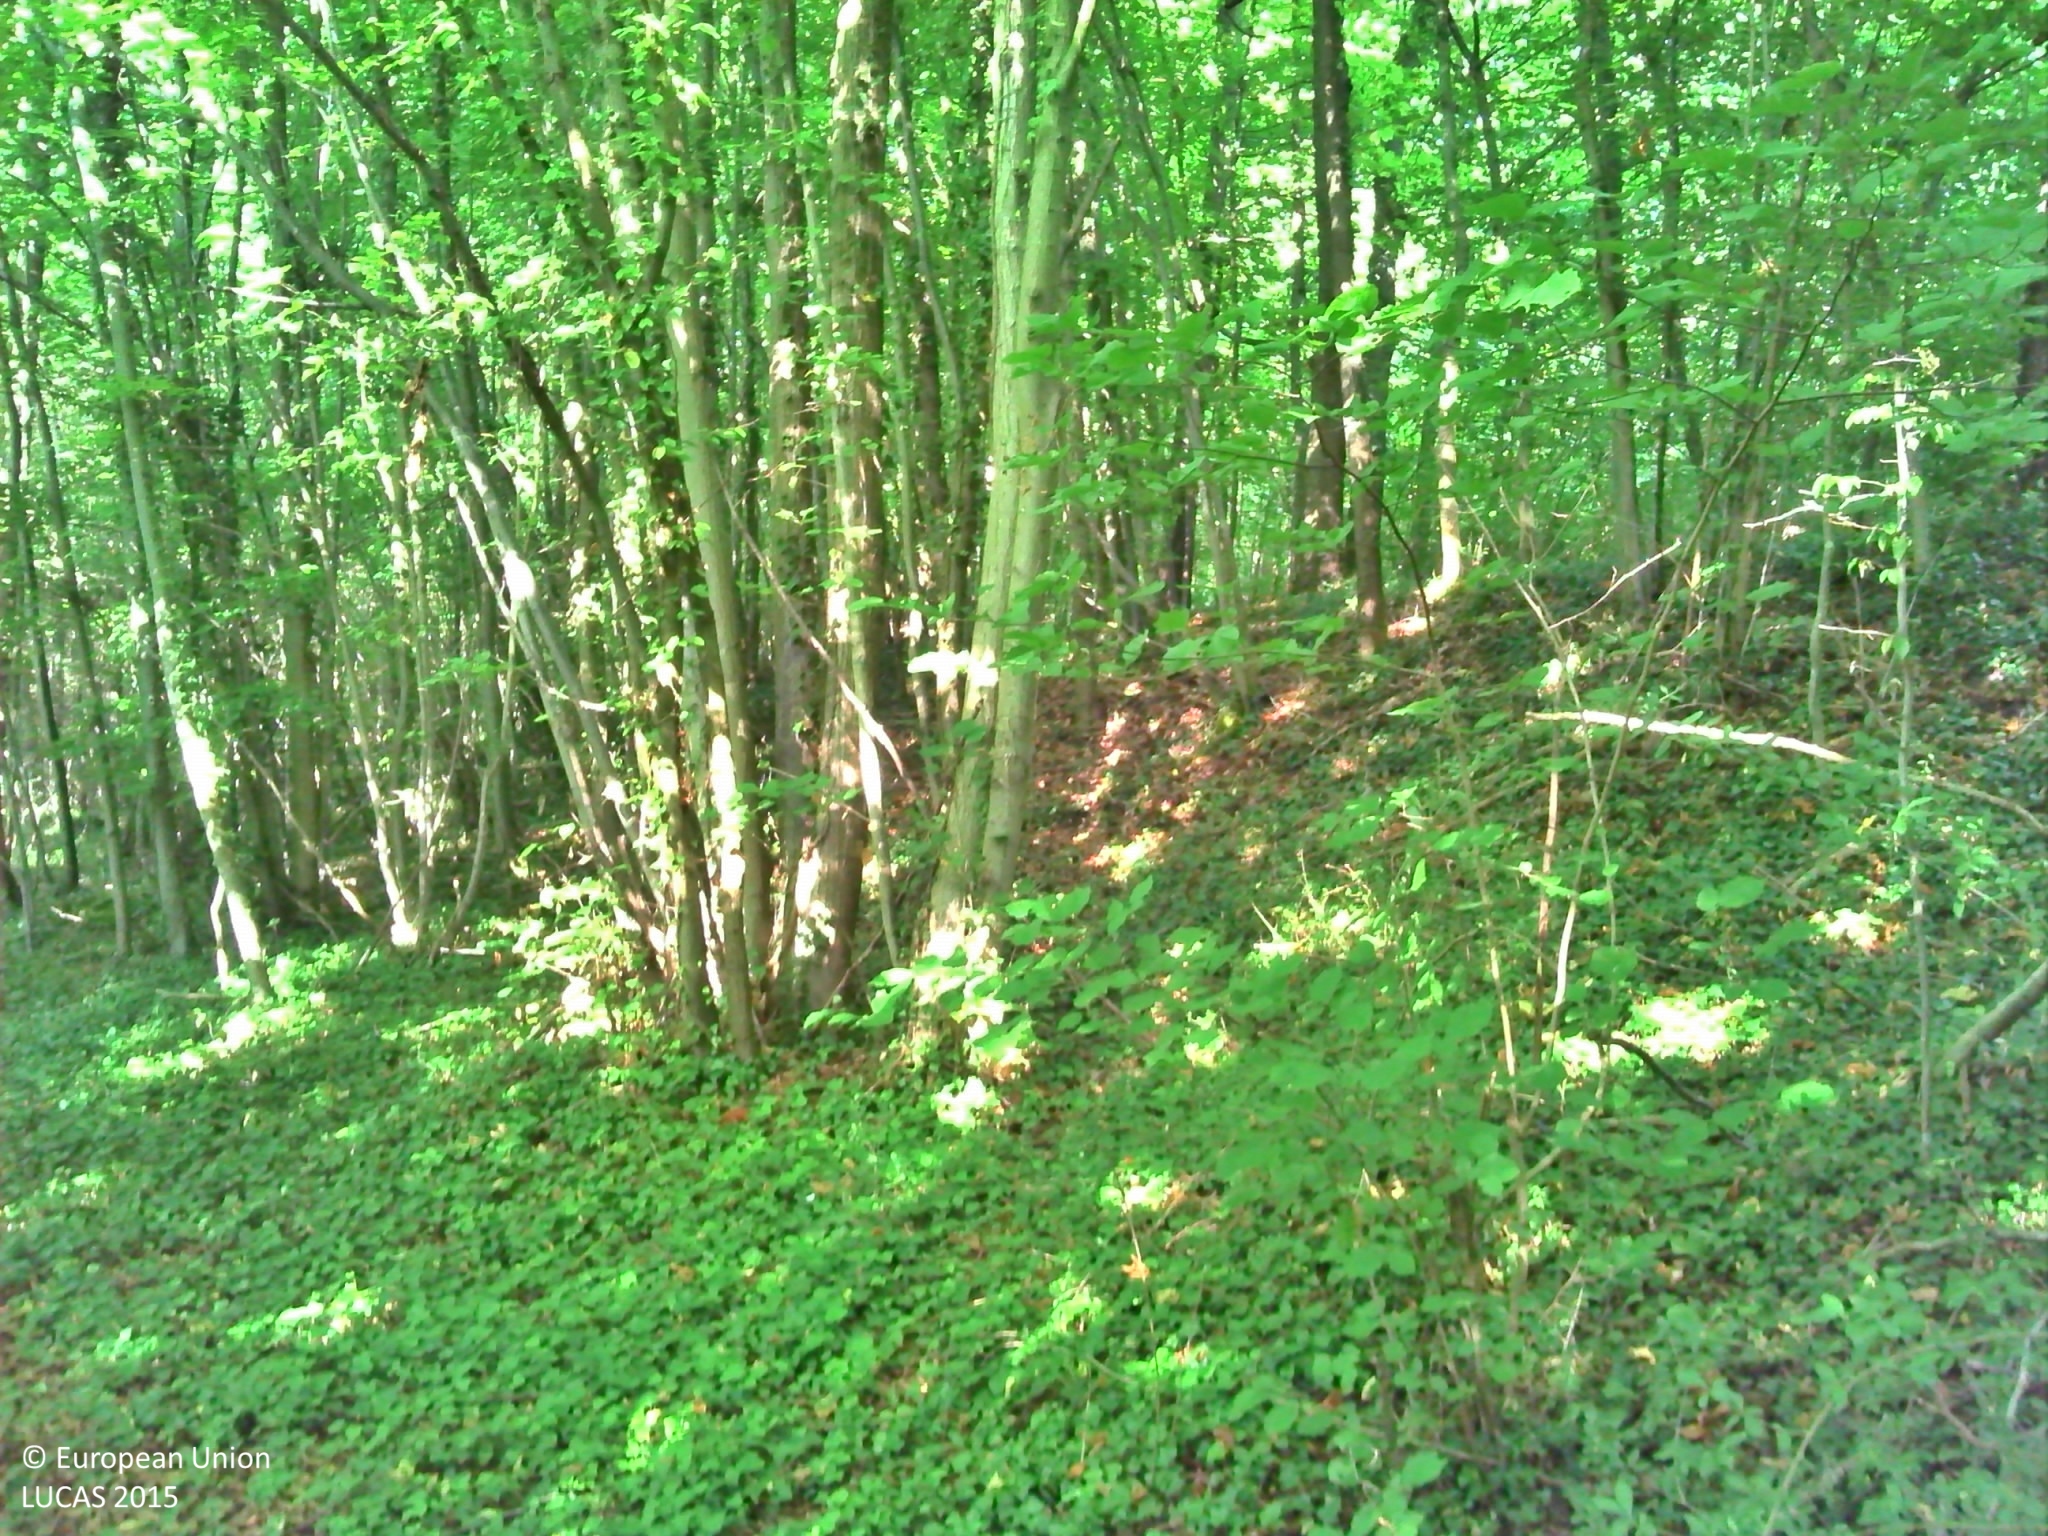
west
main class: Woodland
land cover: Broadleaved woodland
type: beech forest
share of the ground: > 75 %
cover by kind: broadleaved forest trees 70 %, shrubs 15 %, herbaceous plants 15 %
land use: Forestry
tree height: > 5 m
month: July
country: FR
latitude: 49.2951
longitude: 2.3559
